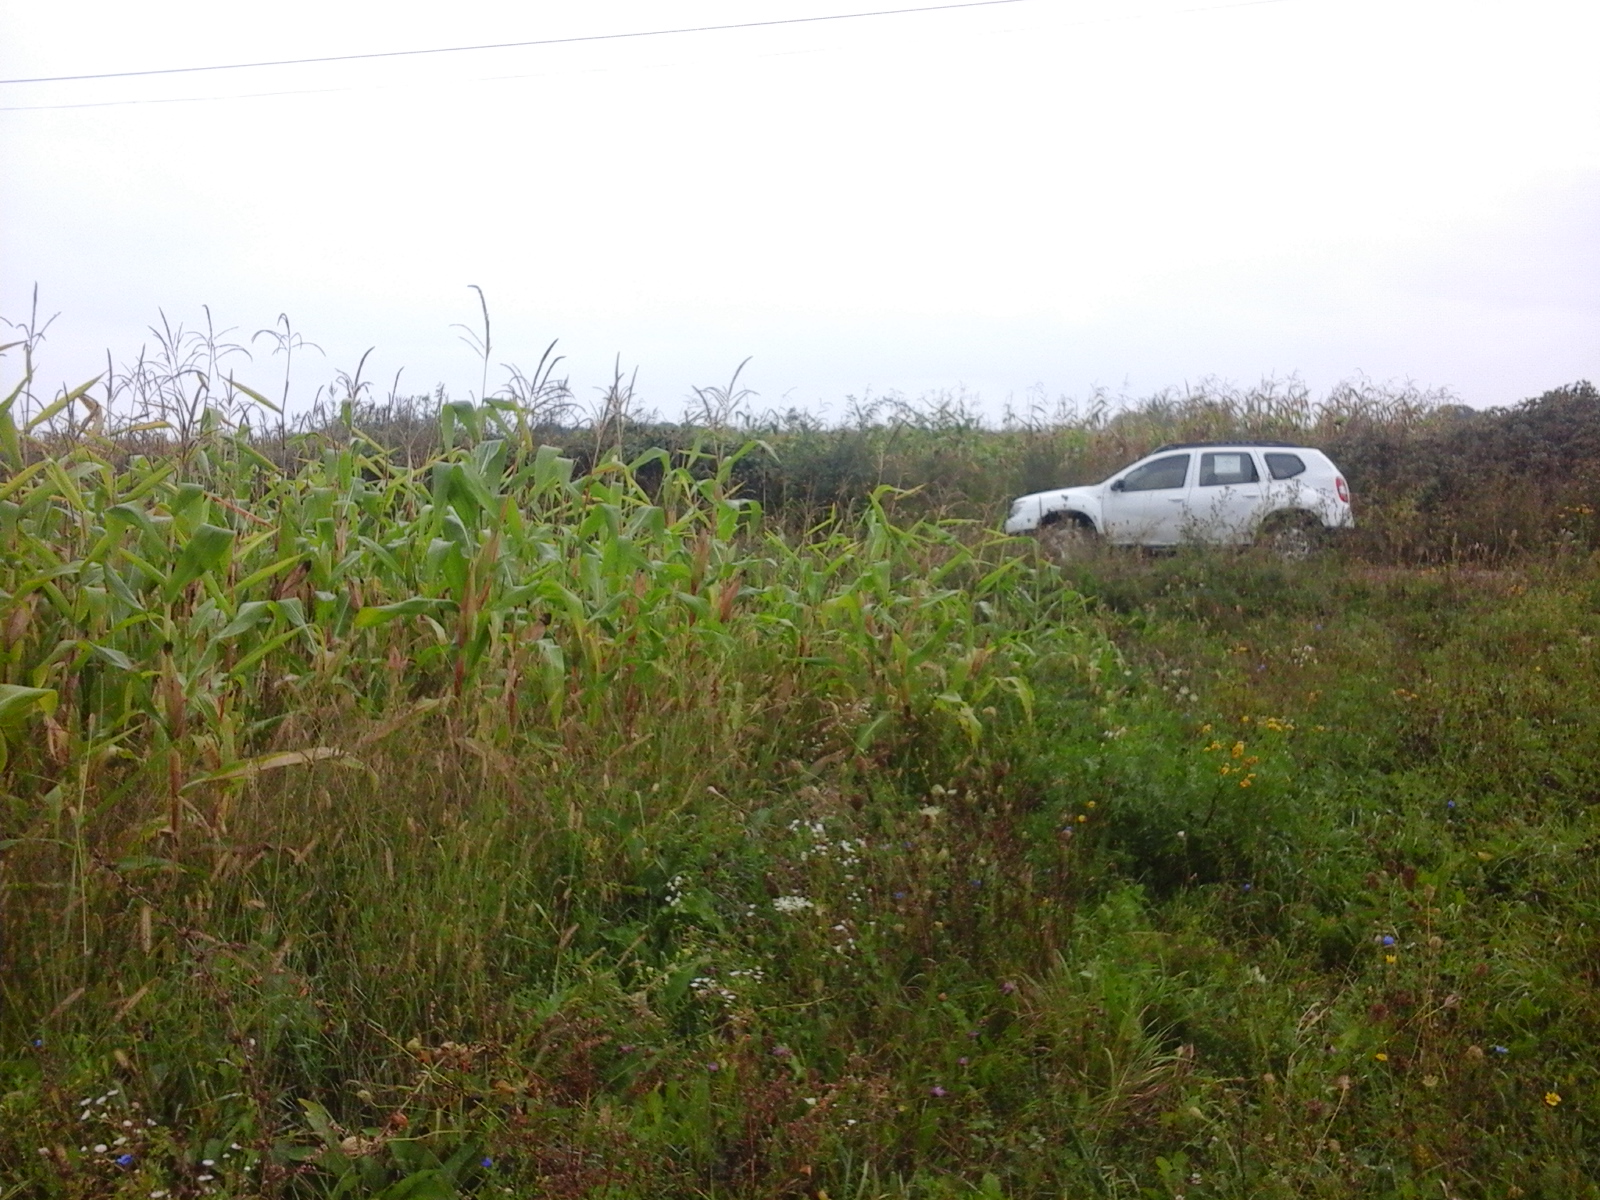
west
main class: Cropland
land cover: Other leguminous and mixtures for fodder
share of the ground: > 75 %
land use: Agriculture (excluding fallow land and kitchen gardens)
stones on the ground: < 10 %
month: September
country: RO
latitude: 47.1897
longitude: 22.5813
